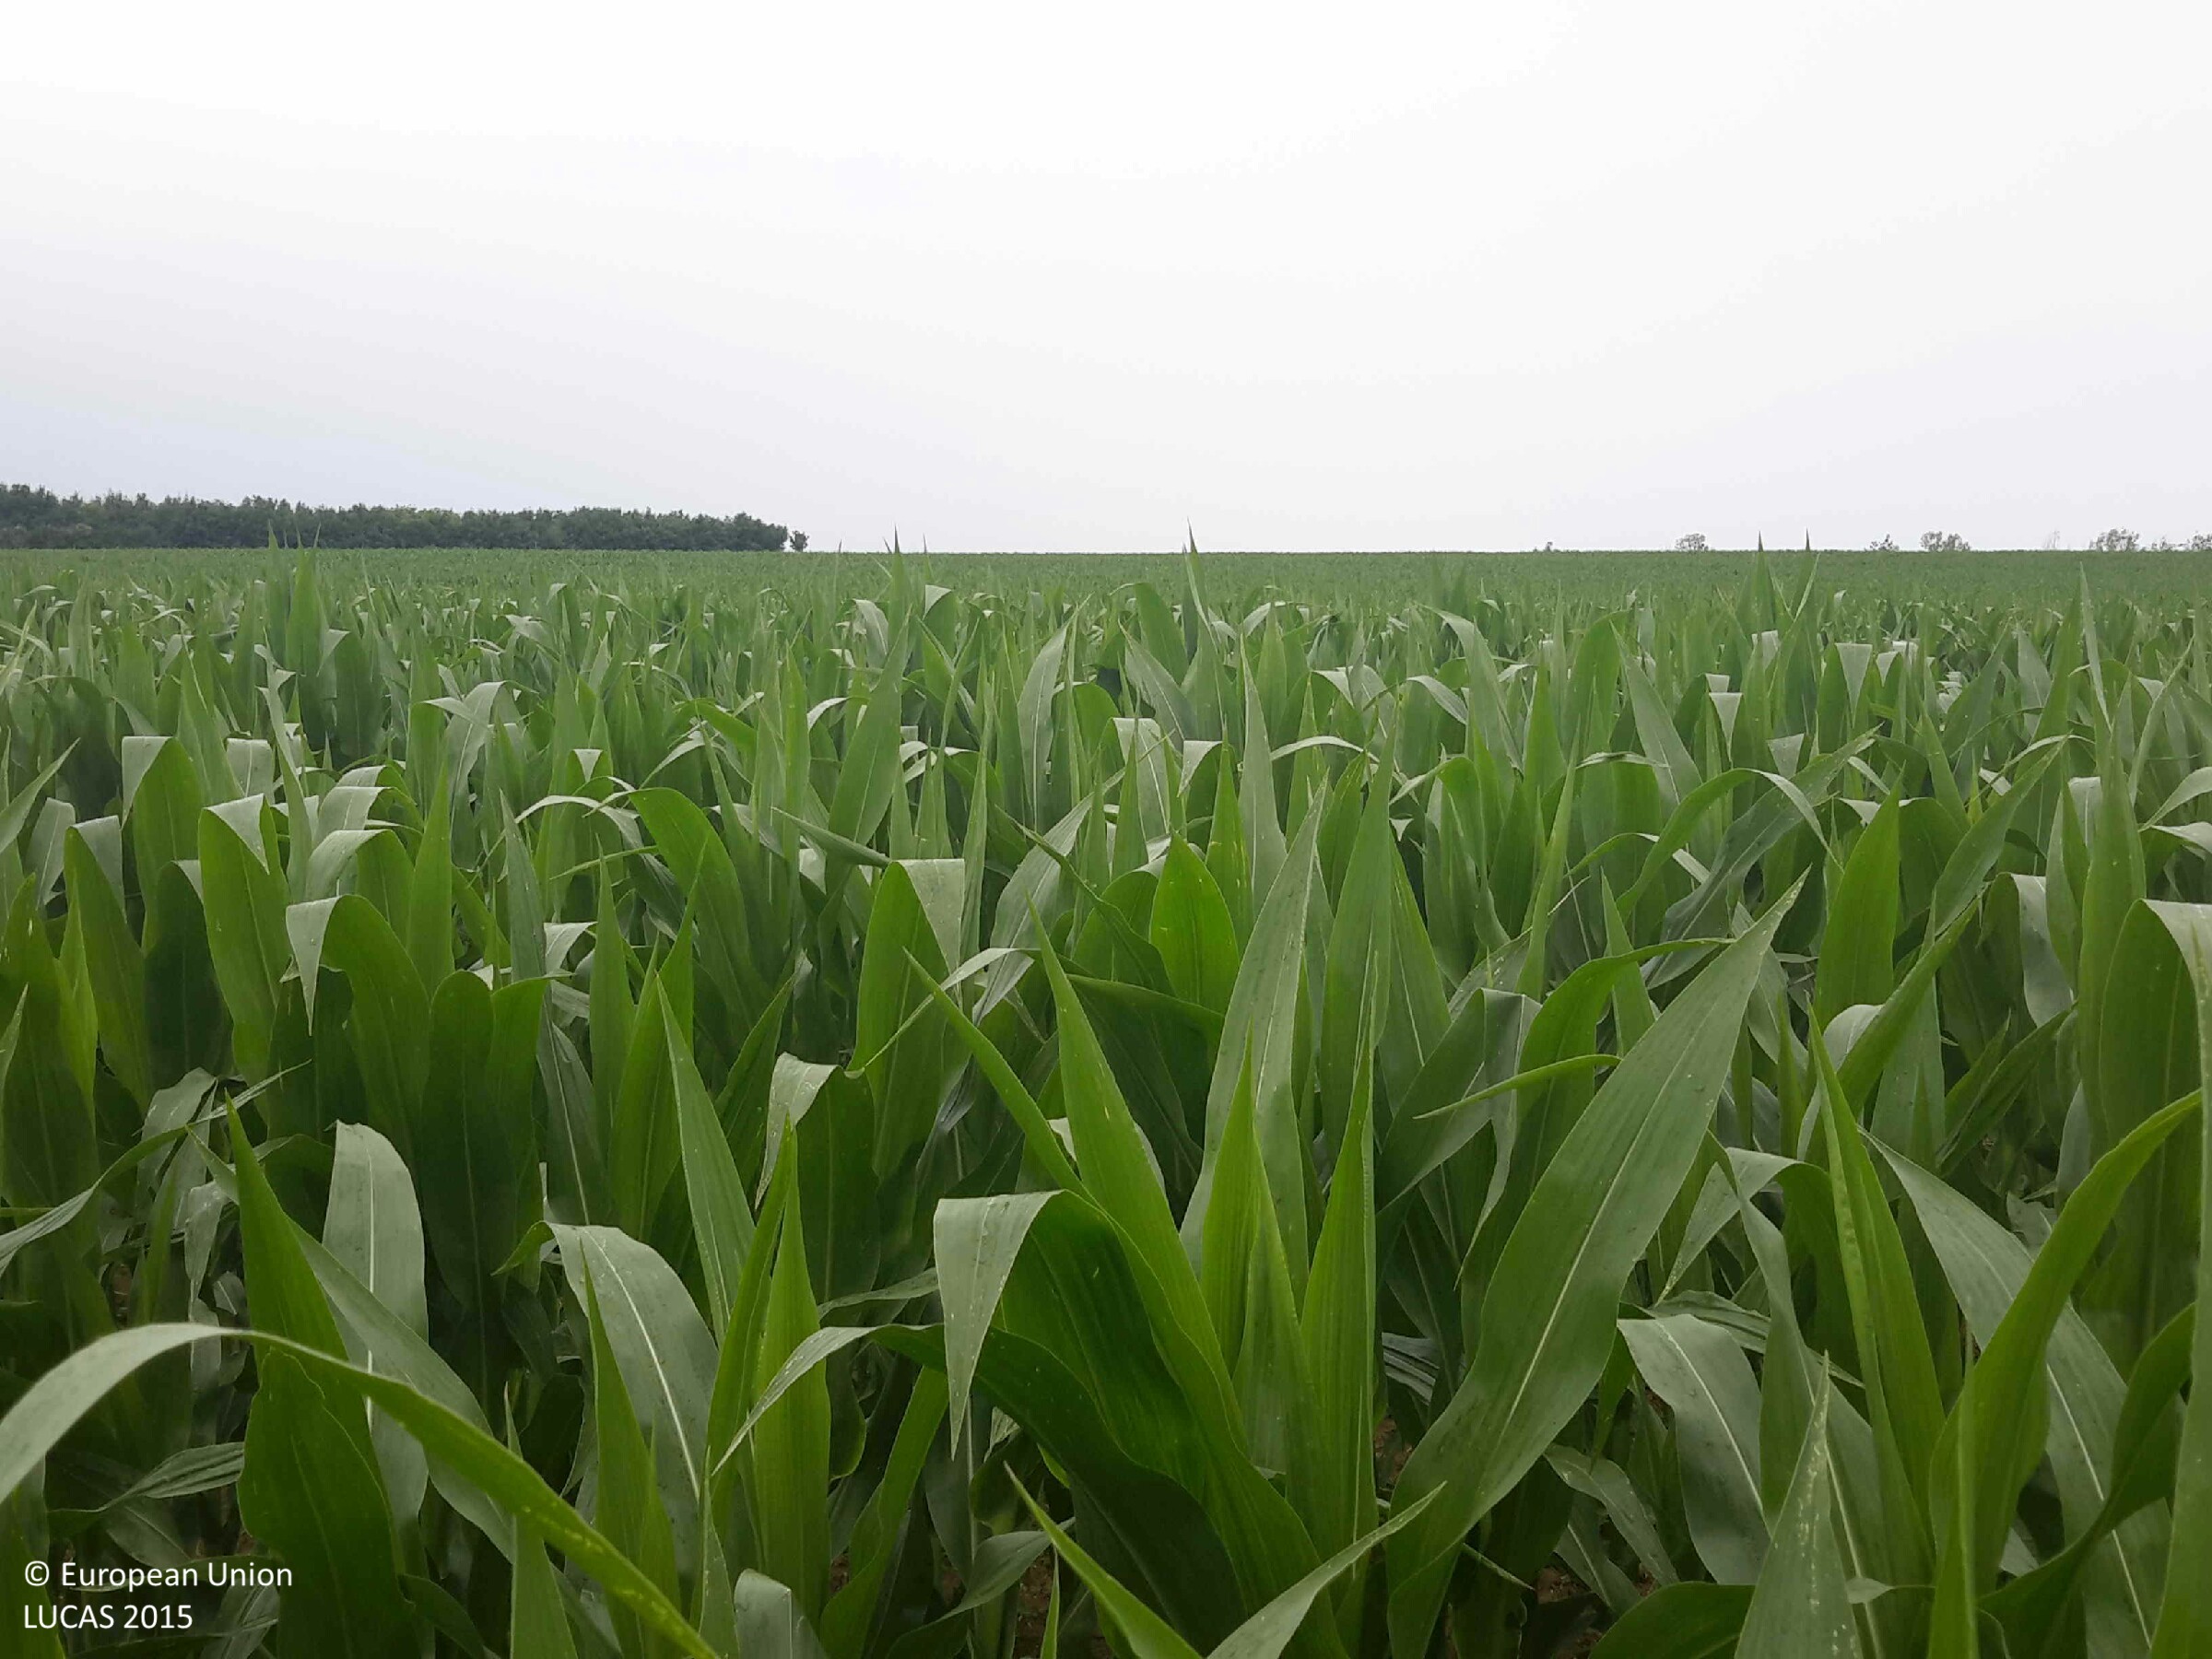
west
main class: Cropland
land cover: Maize
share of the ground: > 75 %
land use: Agriculture (excluding fallow land and kitchen gardens)
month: July
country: HU
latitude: 47.5655
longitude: 16.7438
